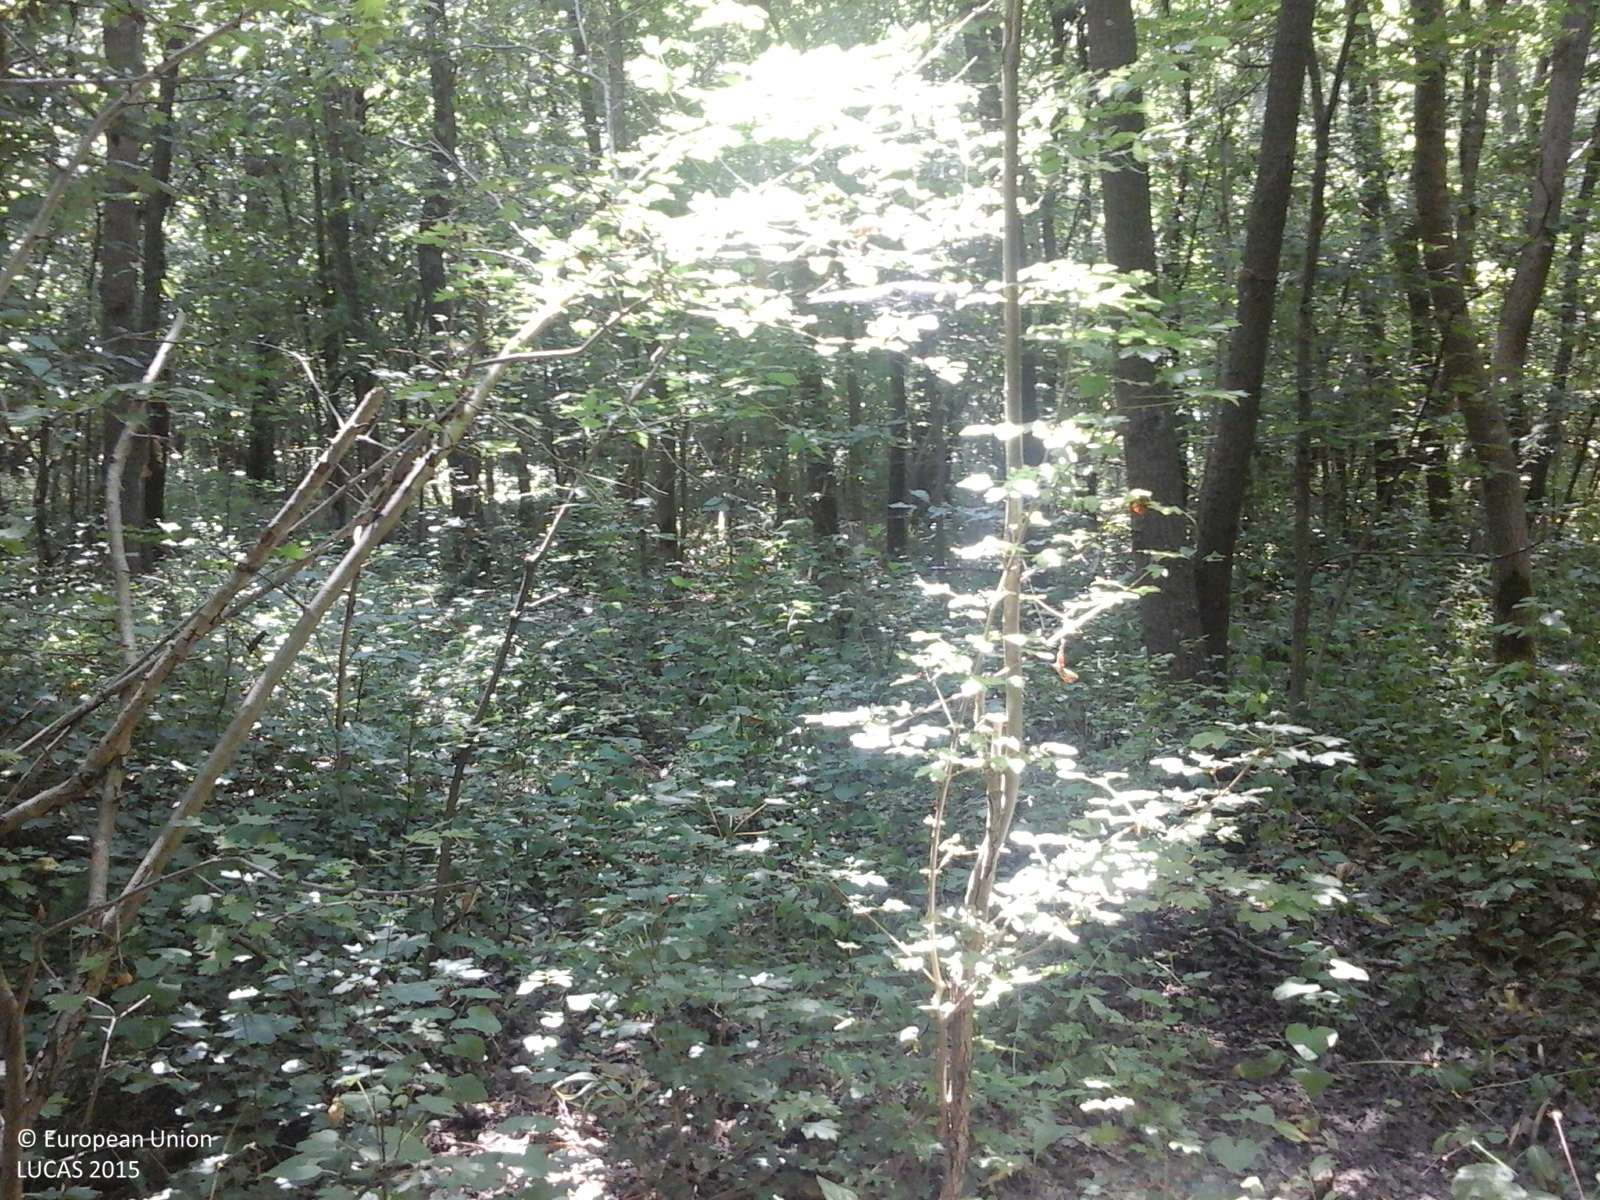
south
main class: Woodland
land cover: Broadleaved woodland
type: mesophytic deciduous forest
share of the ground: > 75 %
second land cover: Spontaneously vegetated surfaces
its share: < 10 %
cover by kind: broadleaved forest trees 90 %, herbaceous plants 10 %
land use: Forestry
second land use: Agriculture (excluding fallow land and kitchen gardens)
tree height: > 5 m
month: July
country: RO
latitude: 44.5166
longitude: 25.3745
